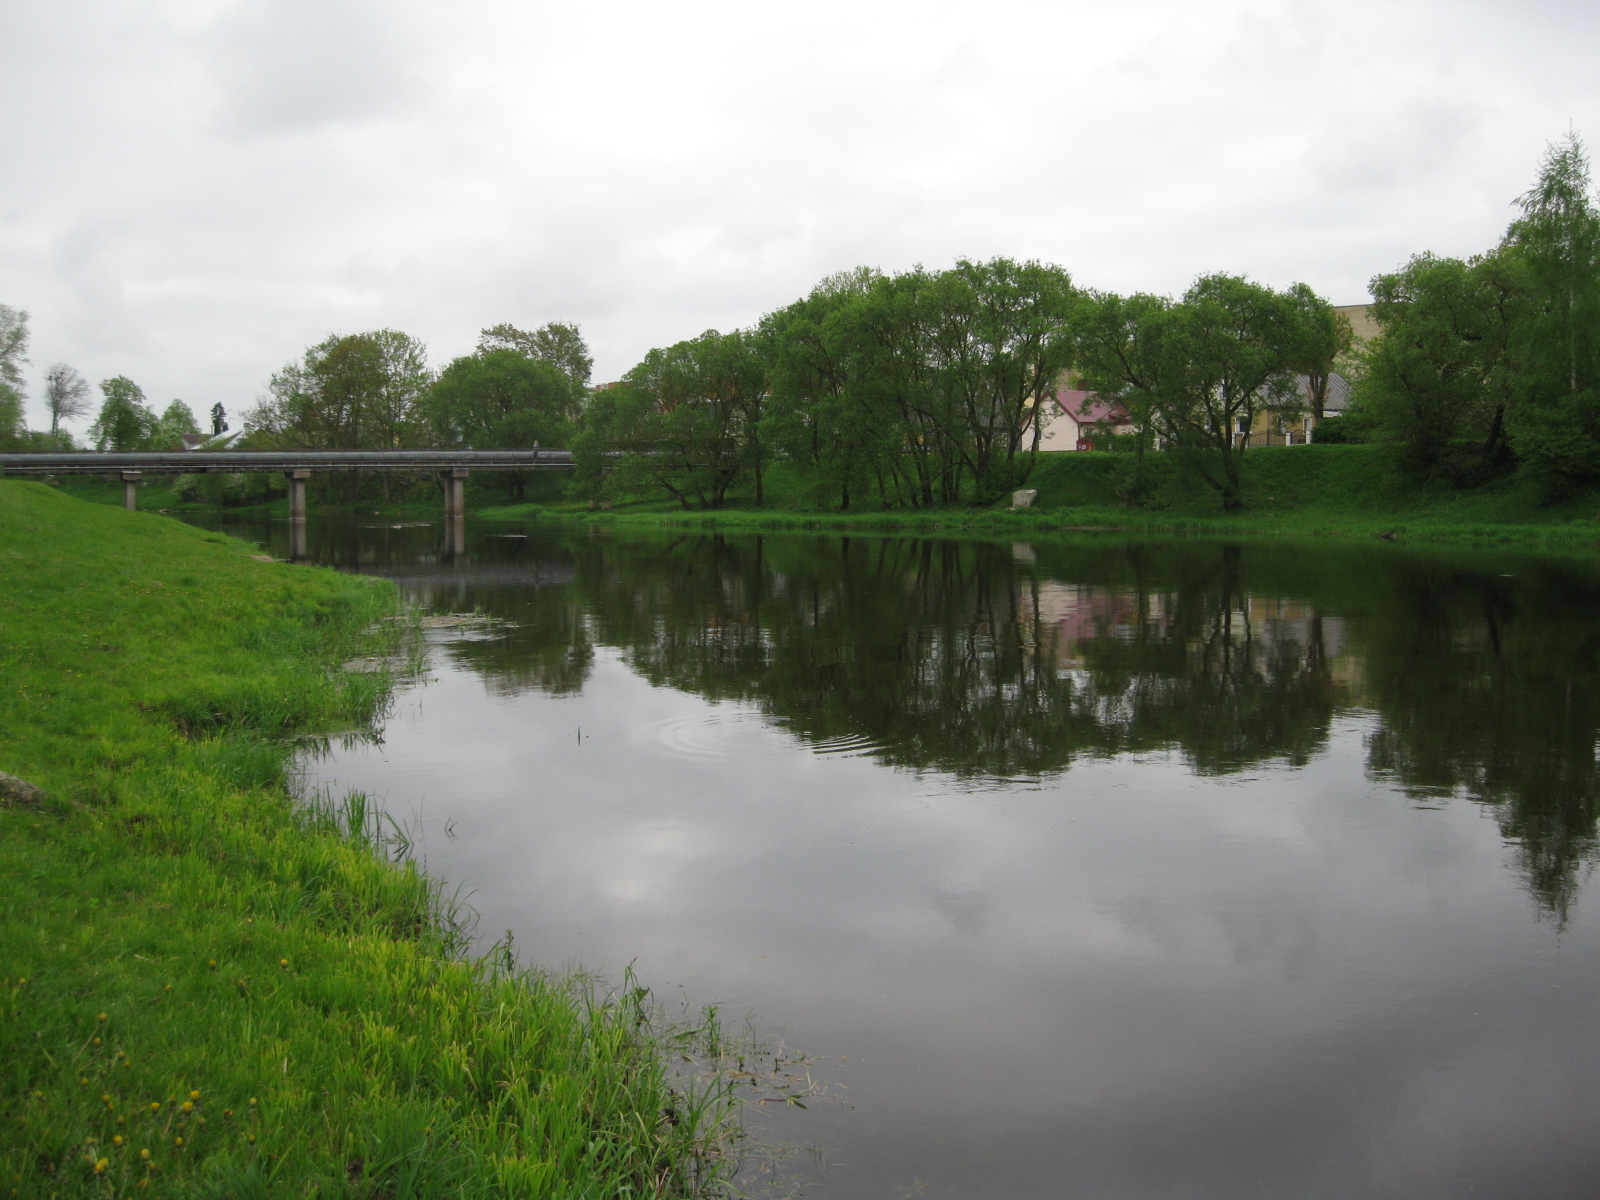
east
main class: Grassland
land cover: Grassland without tree/shrub cover
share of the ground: > 75 %
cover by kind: herbaceous plants 100 %
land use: Amenities, museums, leisure
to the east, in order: Grassland without tree/shrub cover; Inland fresh running water; Artificial constructions; Inland fresh running water; Grassland without tree/shrub cover; Broadleaved woodland; Artificial constructions in urban areas
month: May
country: LT
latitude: 56.0642
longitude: 24.4065
